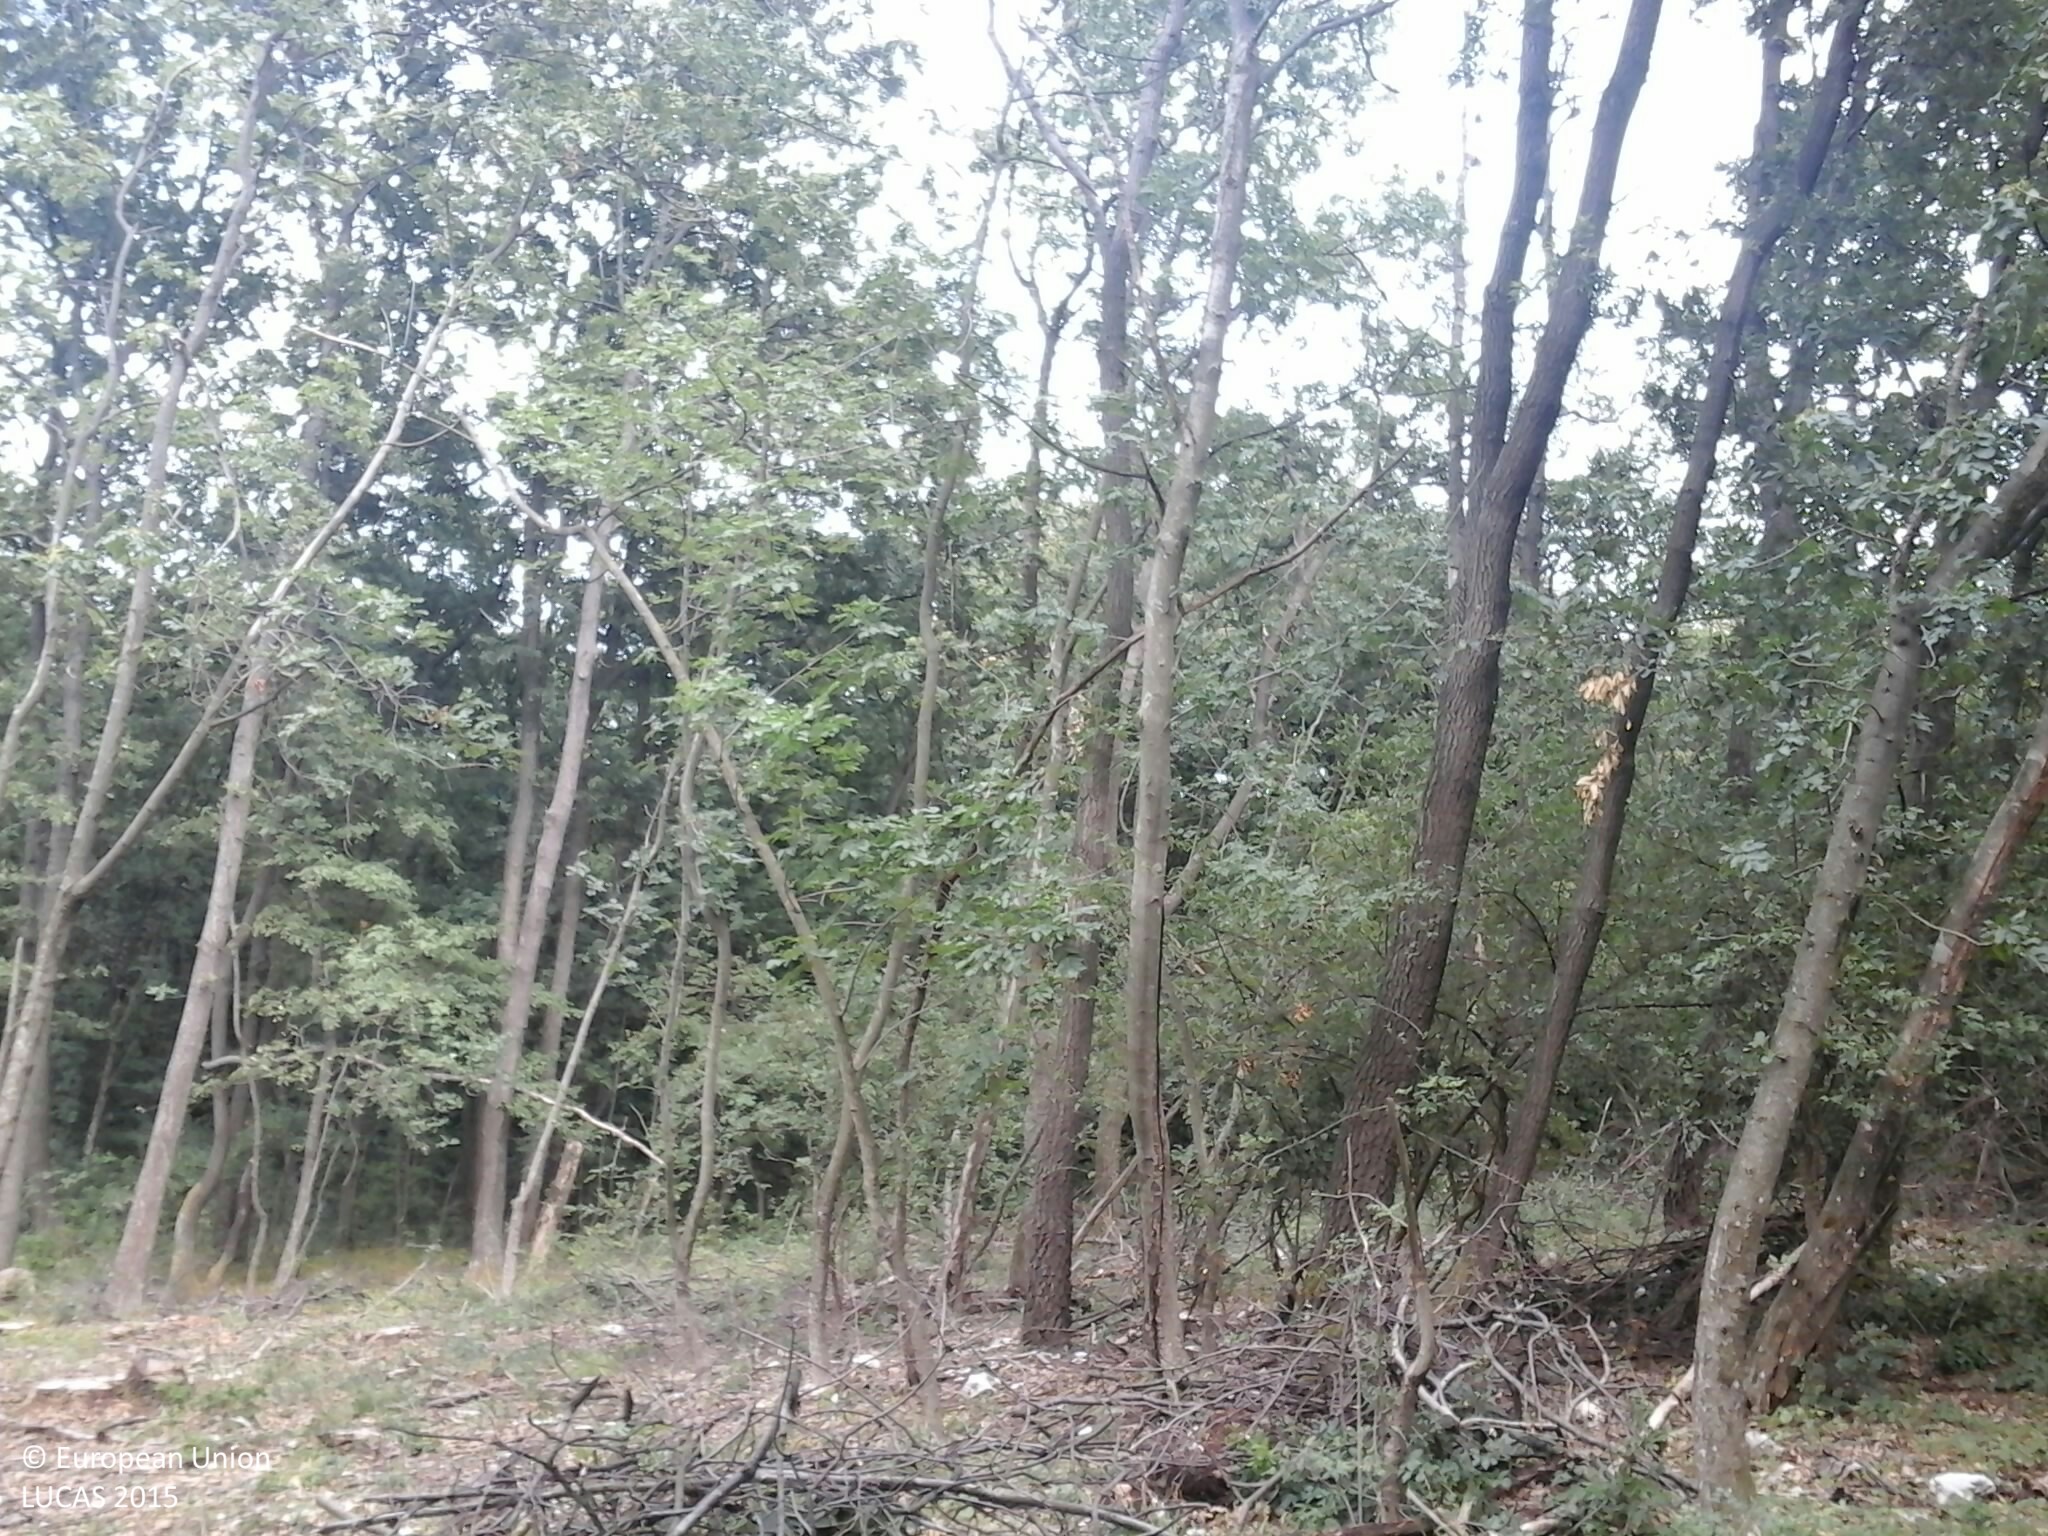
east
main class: Woodland
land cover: Broadleaved woodland
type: acidophilous oak and oak-birch forest
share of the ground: 50 - 75 %
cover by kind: broadleaved forest trees 75 %, herbaceous plants 15 %, consolidated bare surface 10 %
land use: Forestry
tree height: > 5 m
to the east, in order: Broadleaved woodland; Tracks; Broadleaved woodland
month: July
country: HU
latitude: 46.9563
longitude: 17.7473
